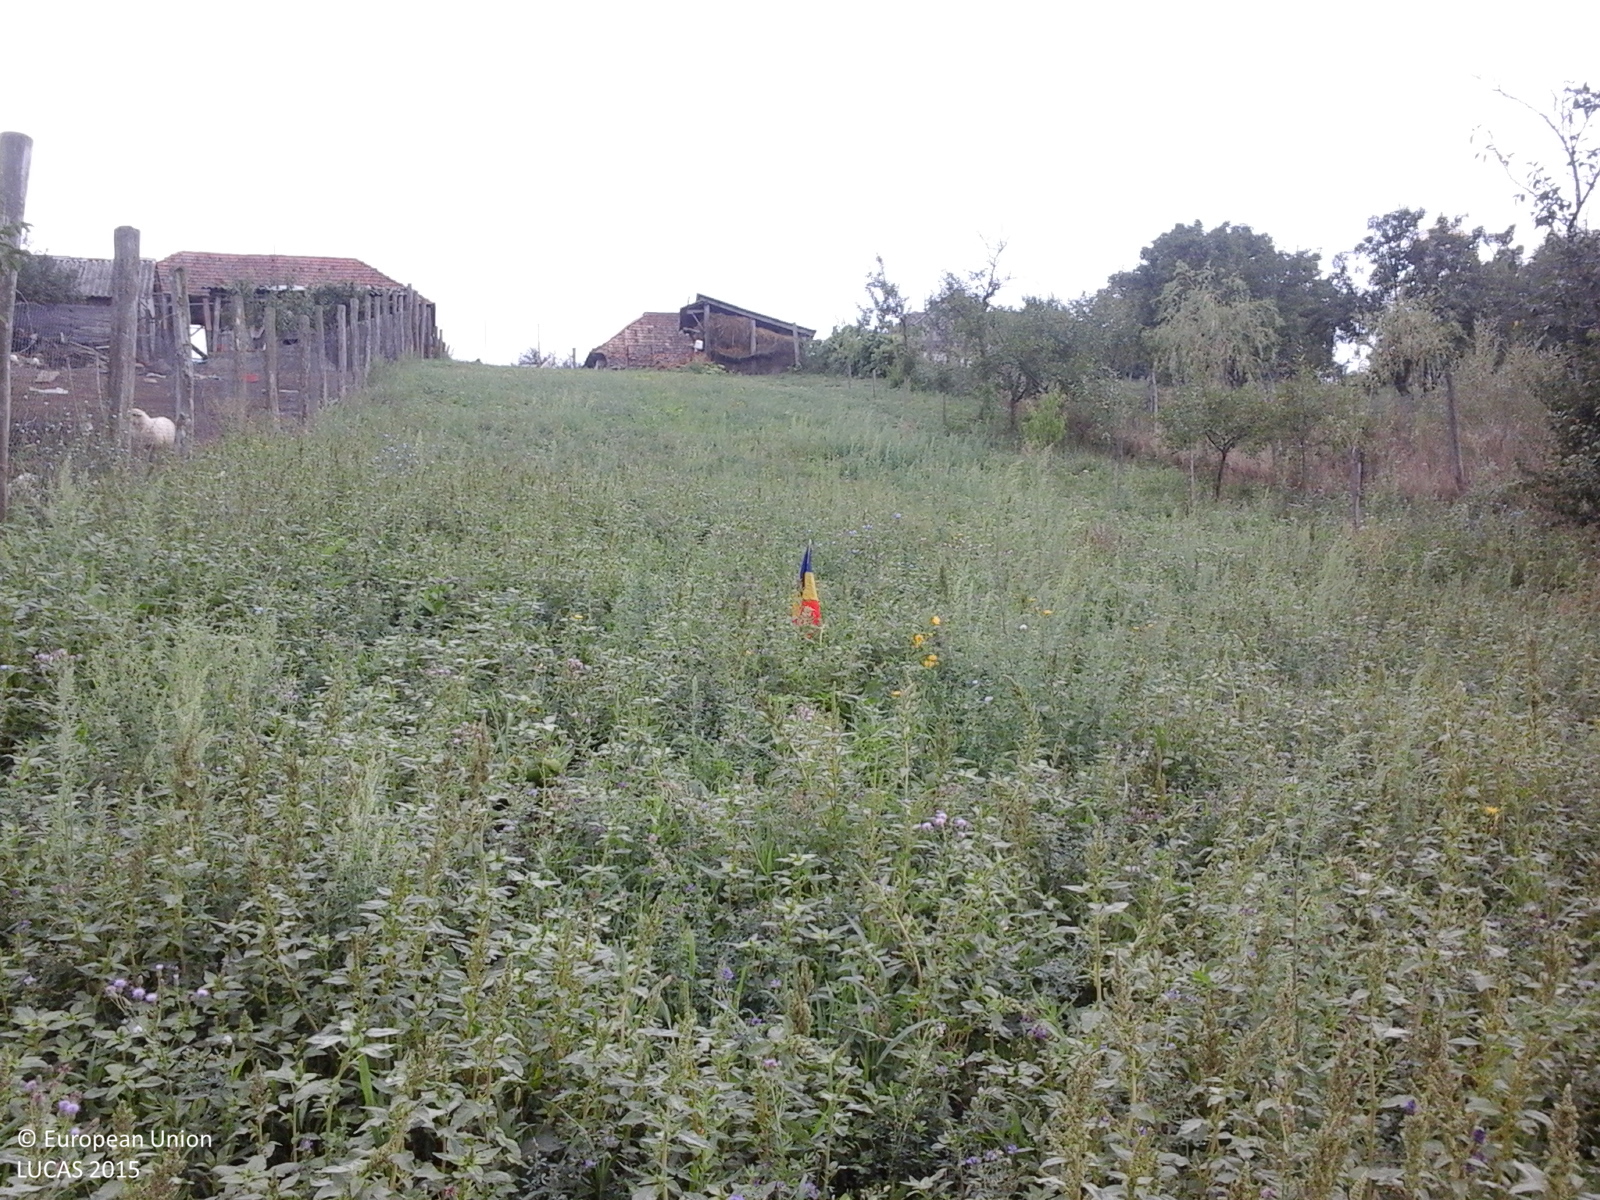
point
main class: Cropland
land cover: Lucerne
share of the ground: > 75 %
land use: Agriculture (excluding fallow land and kitchen gardens)
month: August
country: RO
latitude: 45.9672
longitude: 21.4813
